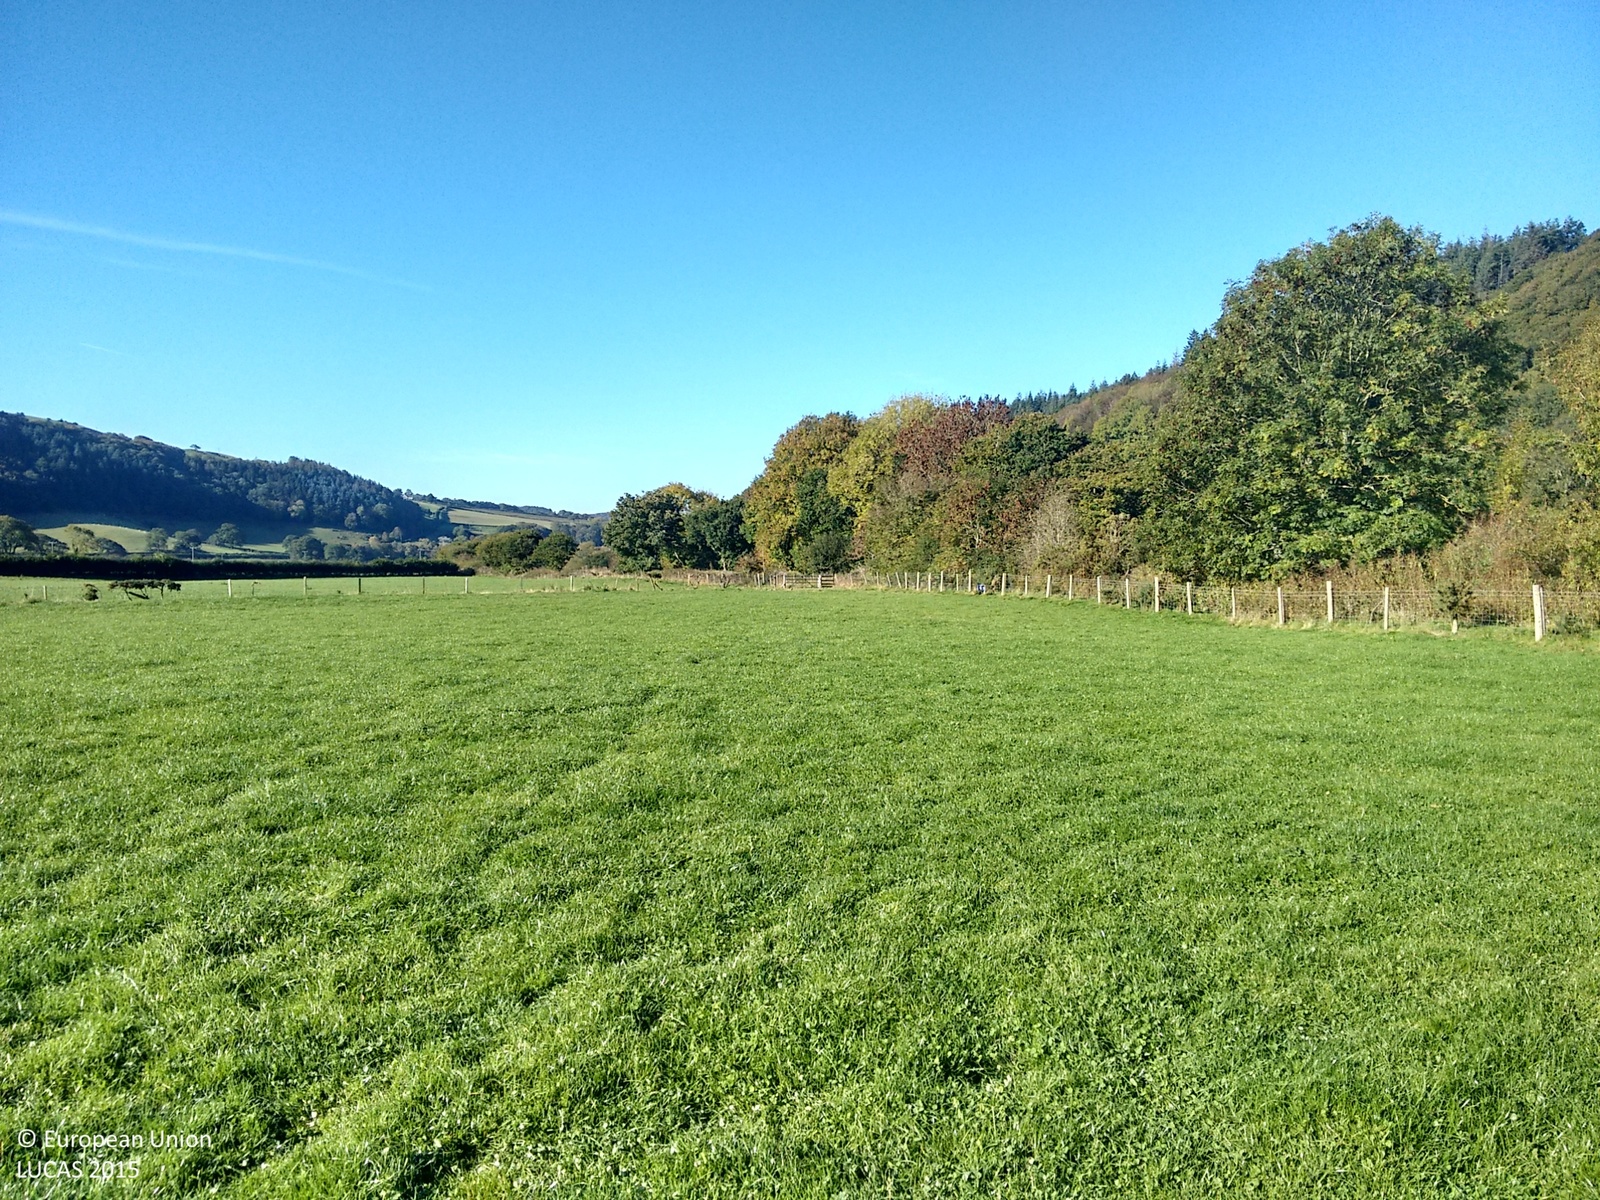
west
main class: Grassland
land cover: Grassland without tree/shrub cover
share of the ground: > 75 %
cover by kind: herbaceous plants 100 %
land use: Agriculture (excluding fallow land and kitchen gardens)
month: October
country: GB
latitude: 52.3604
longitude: -4.0305
